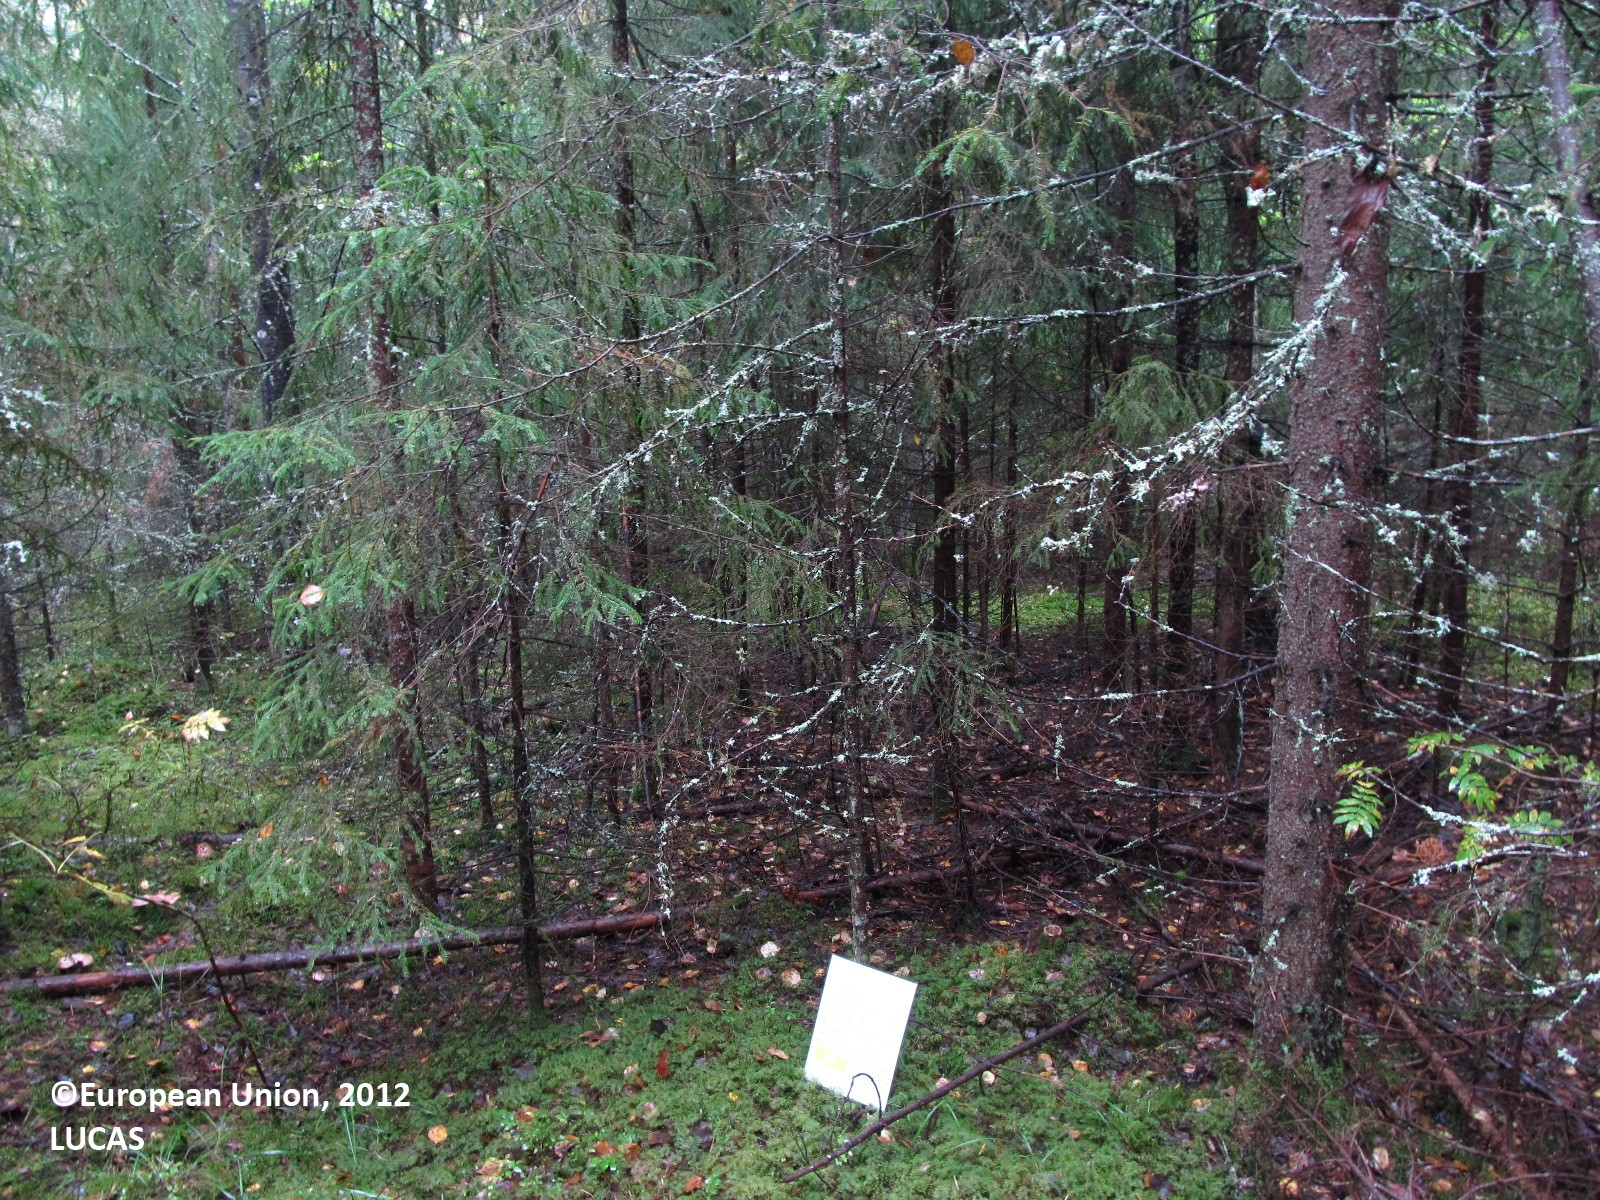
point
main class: Woodland
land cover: Spruce dominated coniferous woodland
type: boreal forest
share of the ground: 50 - 75 %
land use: Forestry
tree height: > 5 m
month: September
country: FI
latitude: 63.1997
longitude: 28.0490
